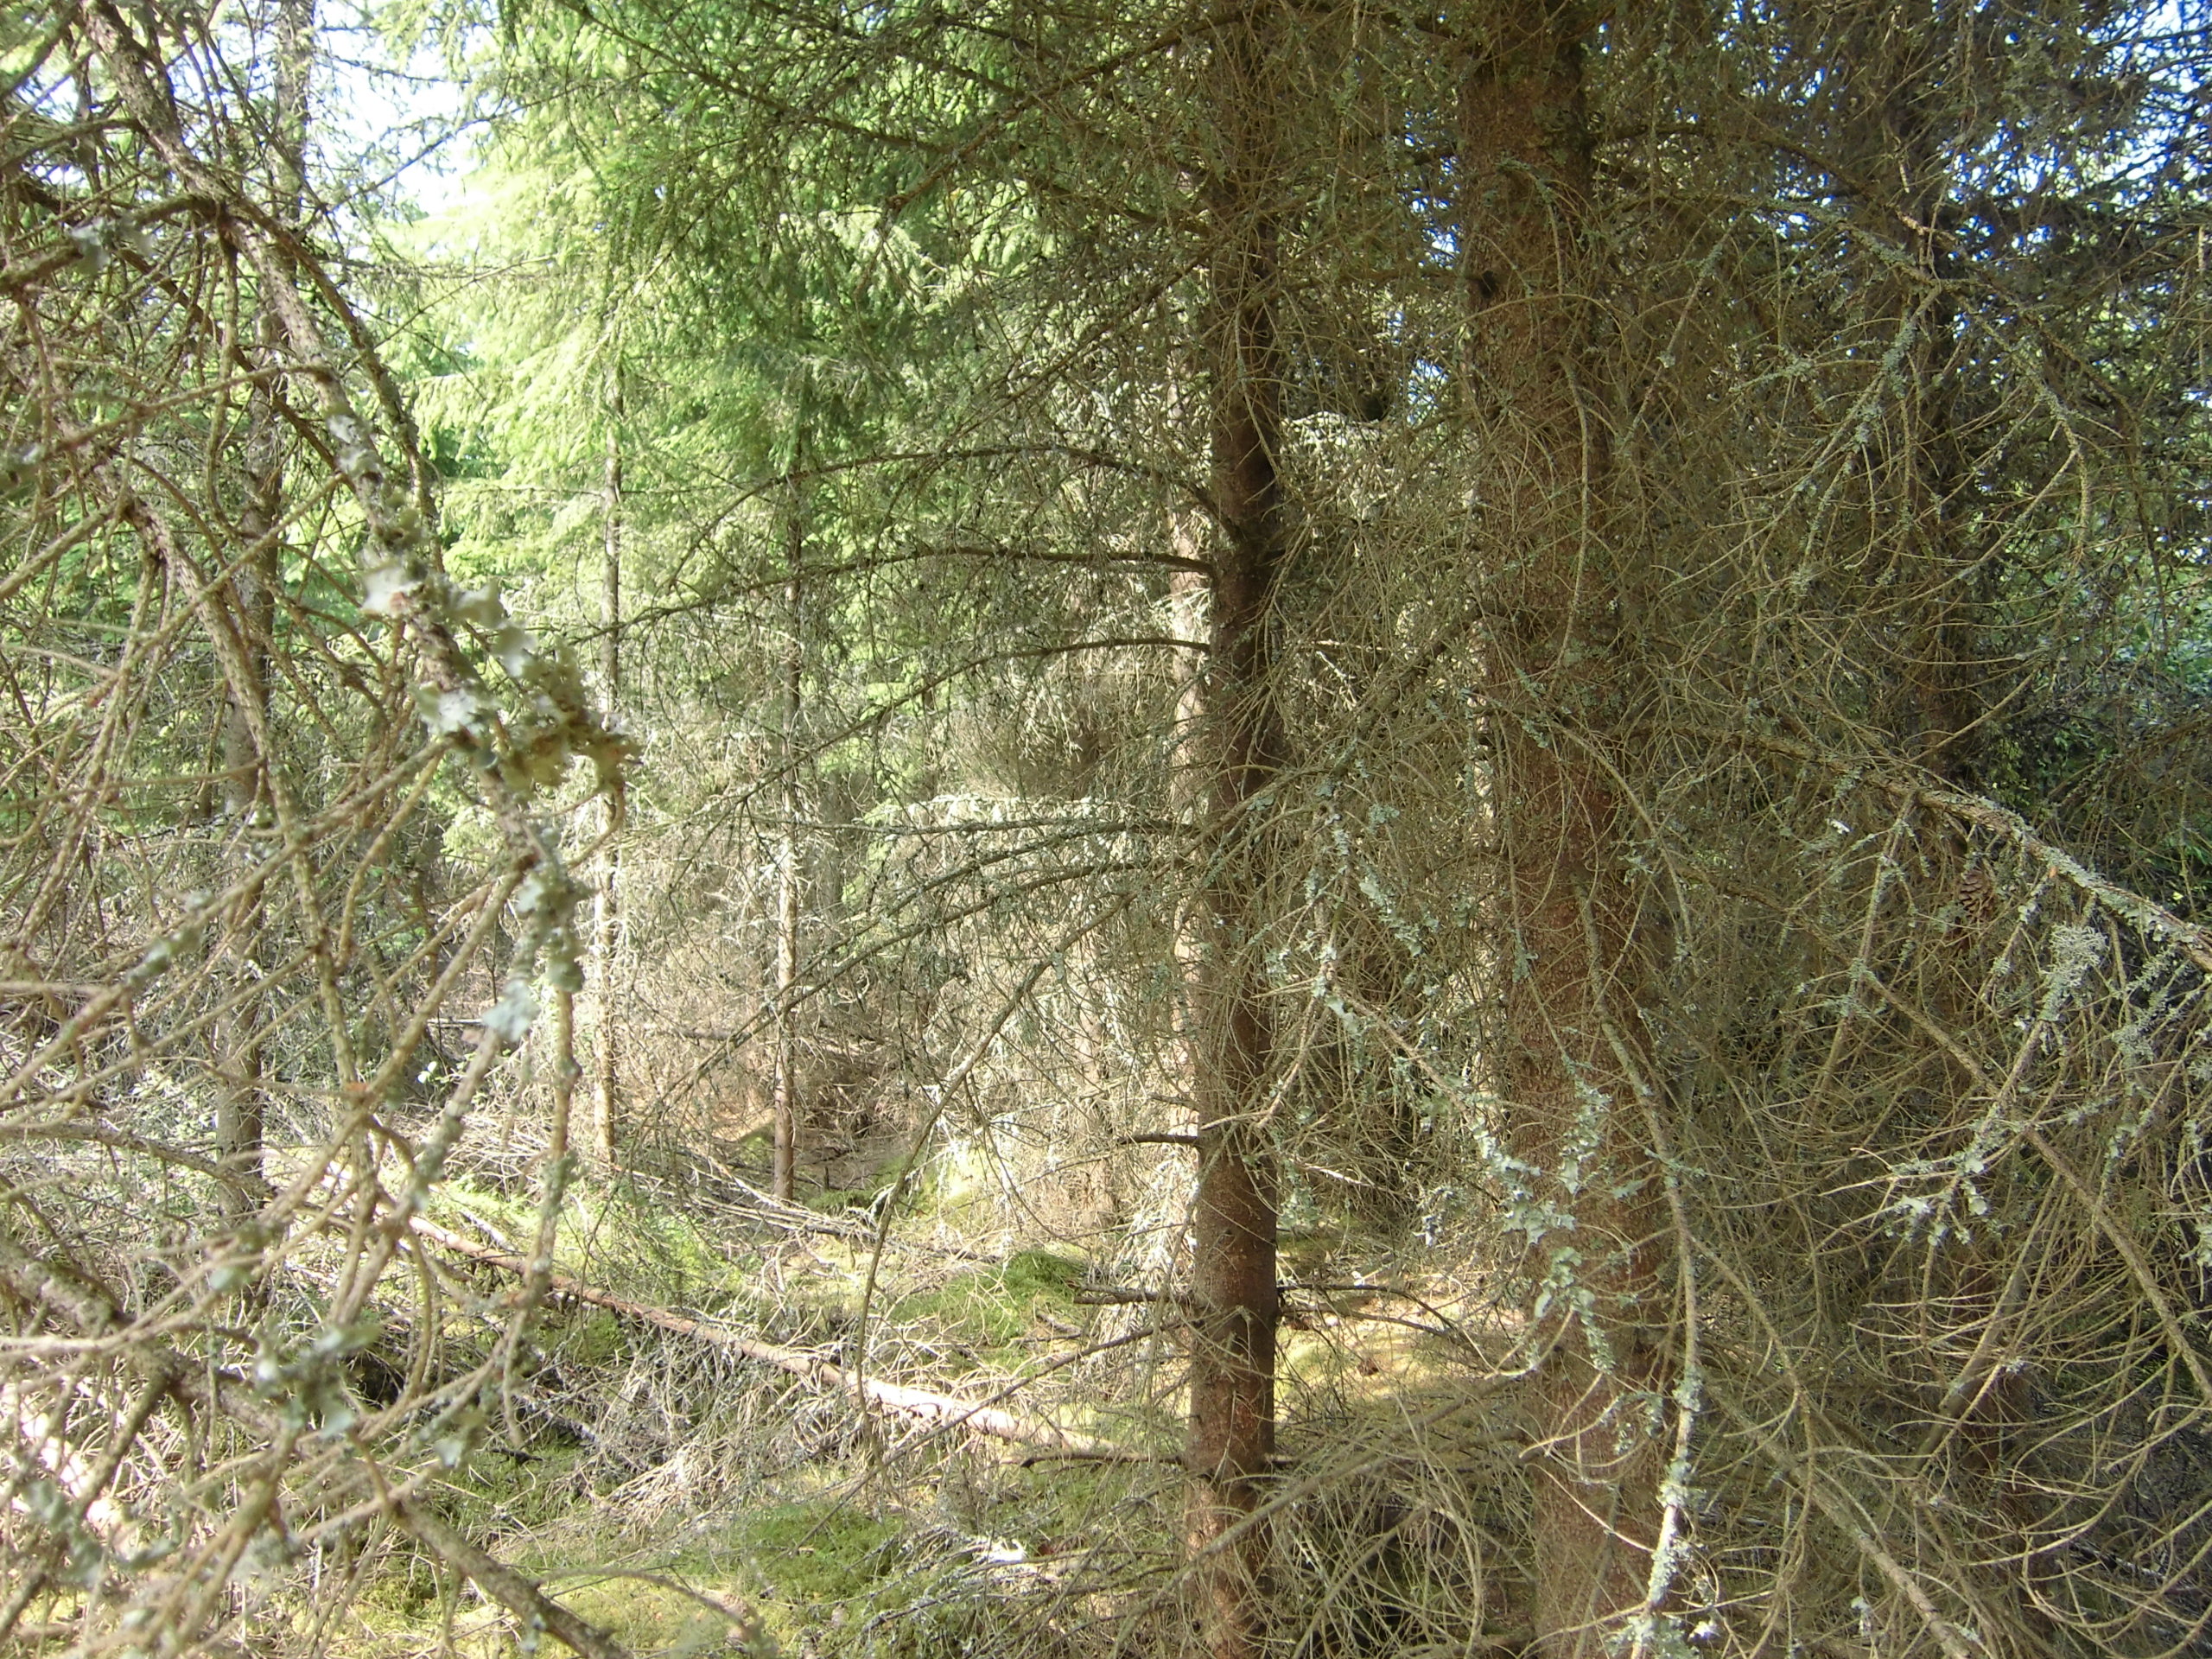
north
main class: Woodland
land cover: Spruce dominated coniferous woodland
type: boreal forest
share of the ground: > 75 %
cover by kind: coniferous forest trees 75 %, lichens and mosses 10 %, unconsolidated bare surface 10 %, broadleaved forest trees 5 %
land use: Forestry
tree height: > 5 m
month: July
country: SE
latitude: 57.3325
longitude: 14.5309
